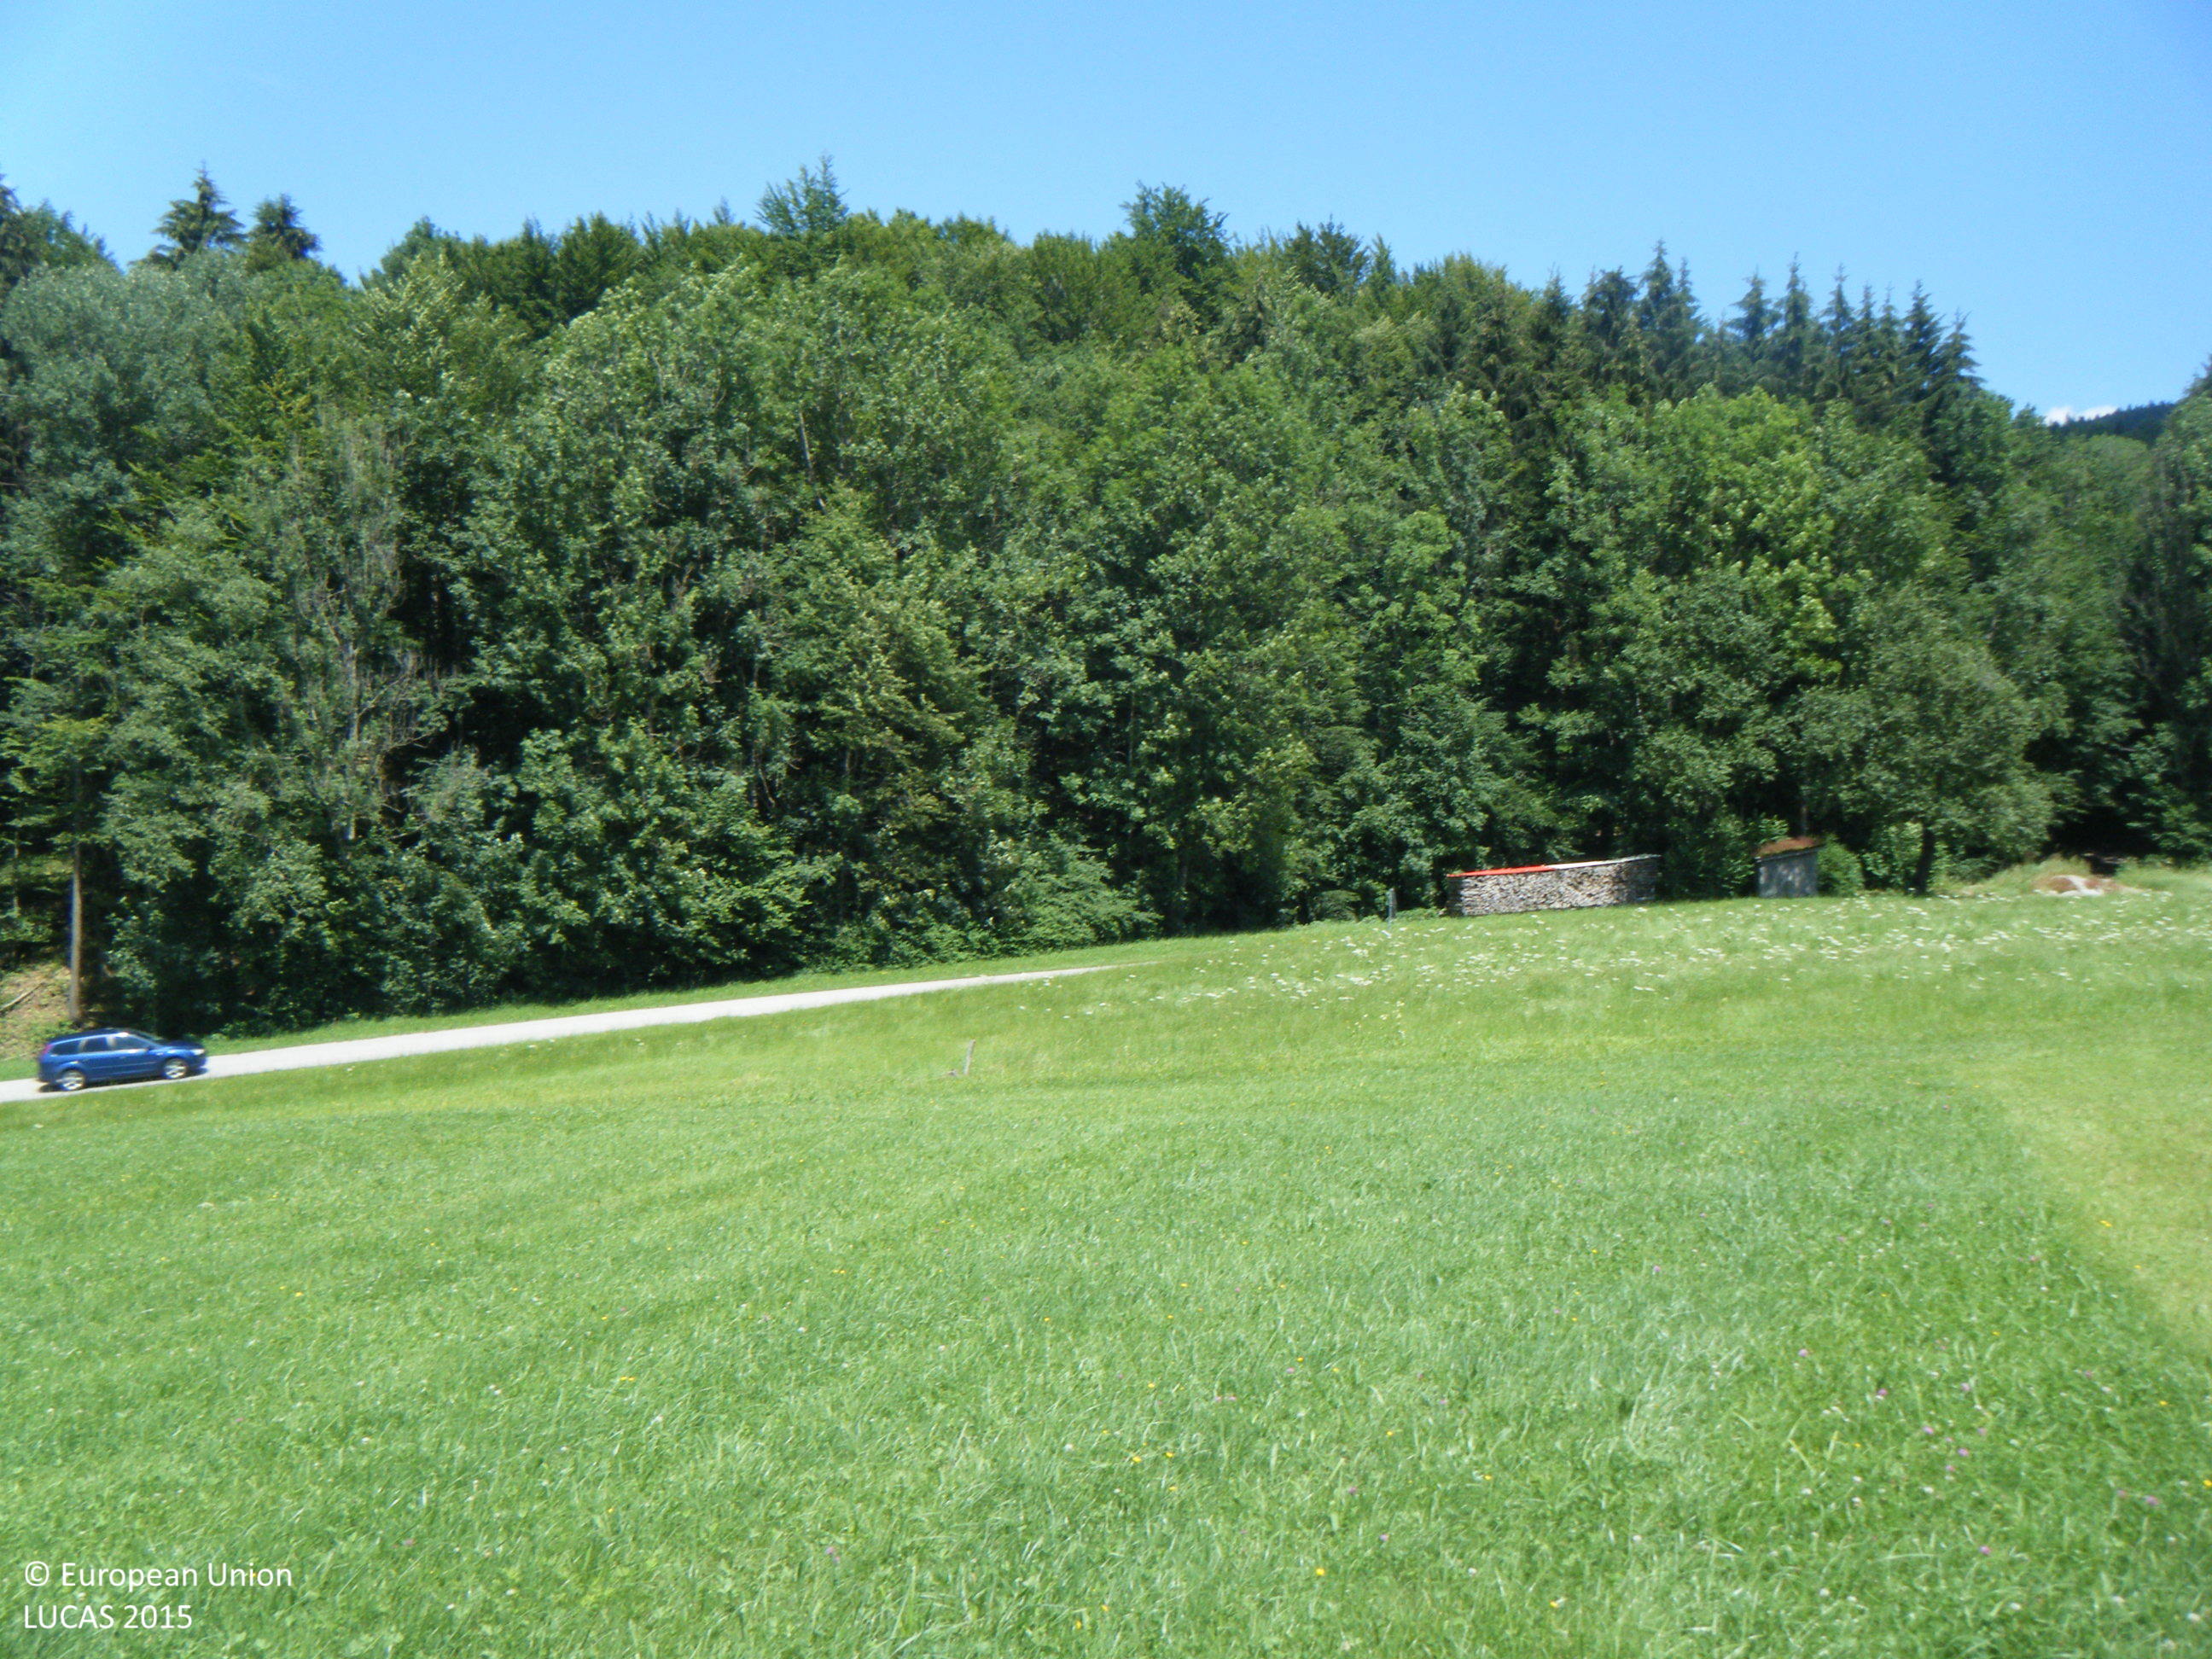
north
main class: Grassland
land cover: Grassland without tree/shrub cover
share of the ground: > 75 %
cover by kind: herbaceous plants 100 %
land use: Agriculture (excluding fallow land and kitchen gardens)
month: July
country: AT
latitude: 47.8451
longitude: 13.4598
